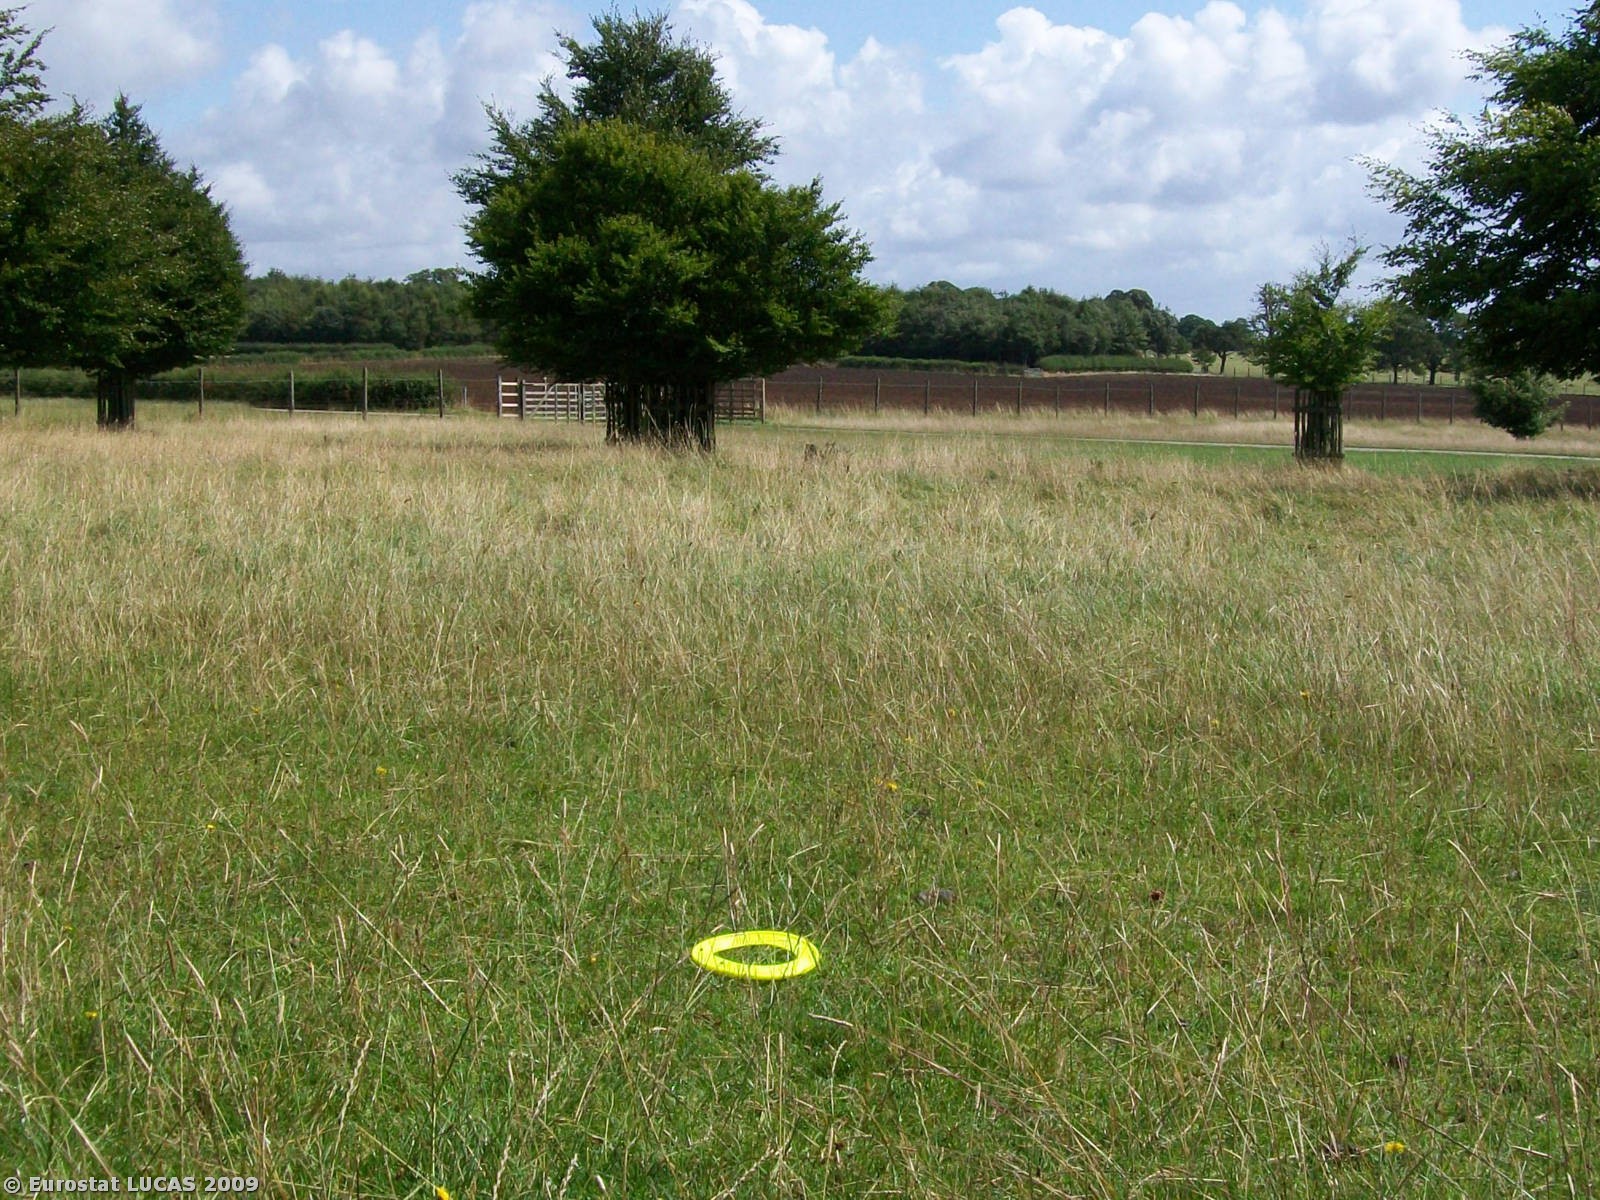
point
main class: Grassland
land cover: Grassland without tree/shrub cover
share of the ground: > 75 %
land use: Amenities, museums, leisure
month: July
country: GB
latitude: 51.5551
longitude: -2.2791
